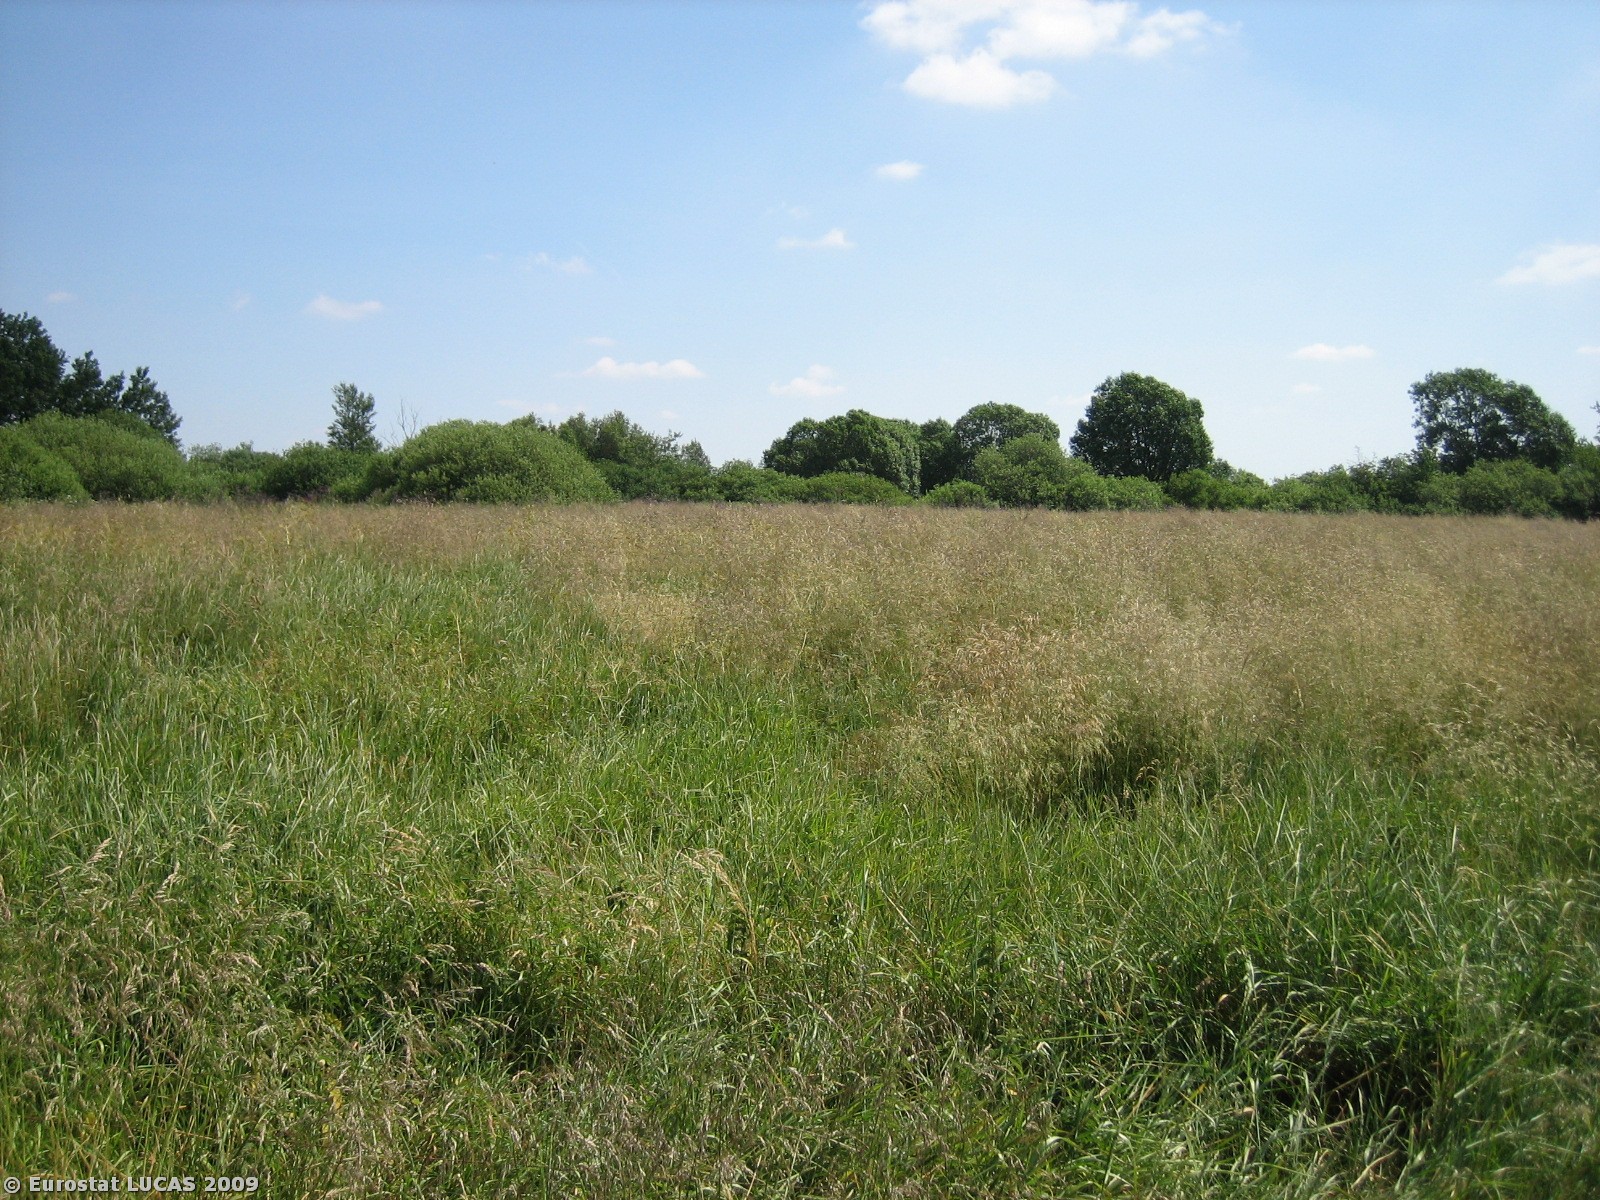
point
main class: Grassland
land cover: Grassland without tree/shrub cover
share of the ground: > 75 %
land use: Unused
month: July
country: DK
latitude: 55.4458
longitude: 8.8786
